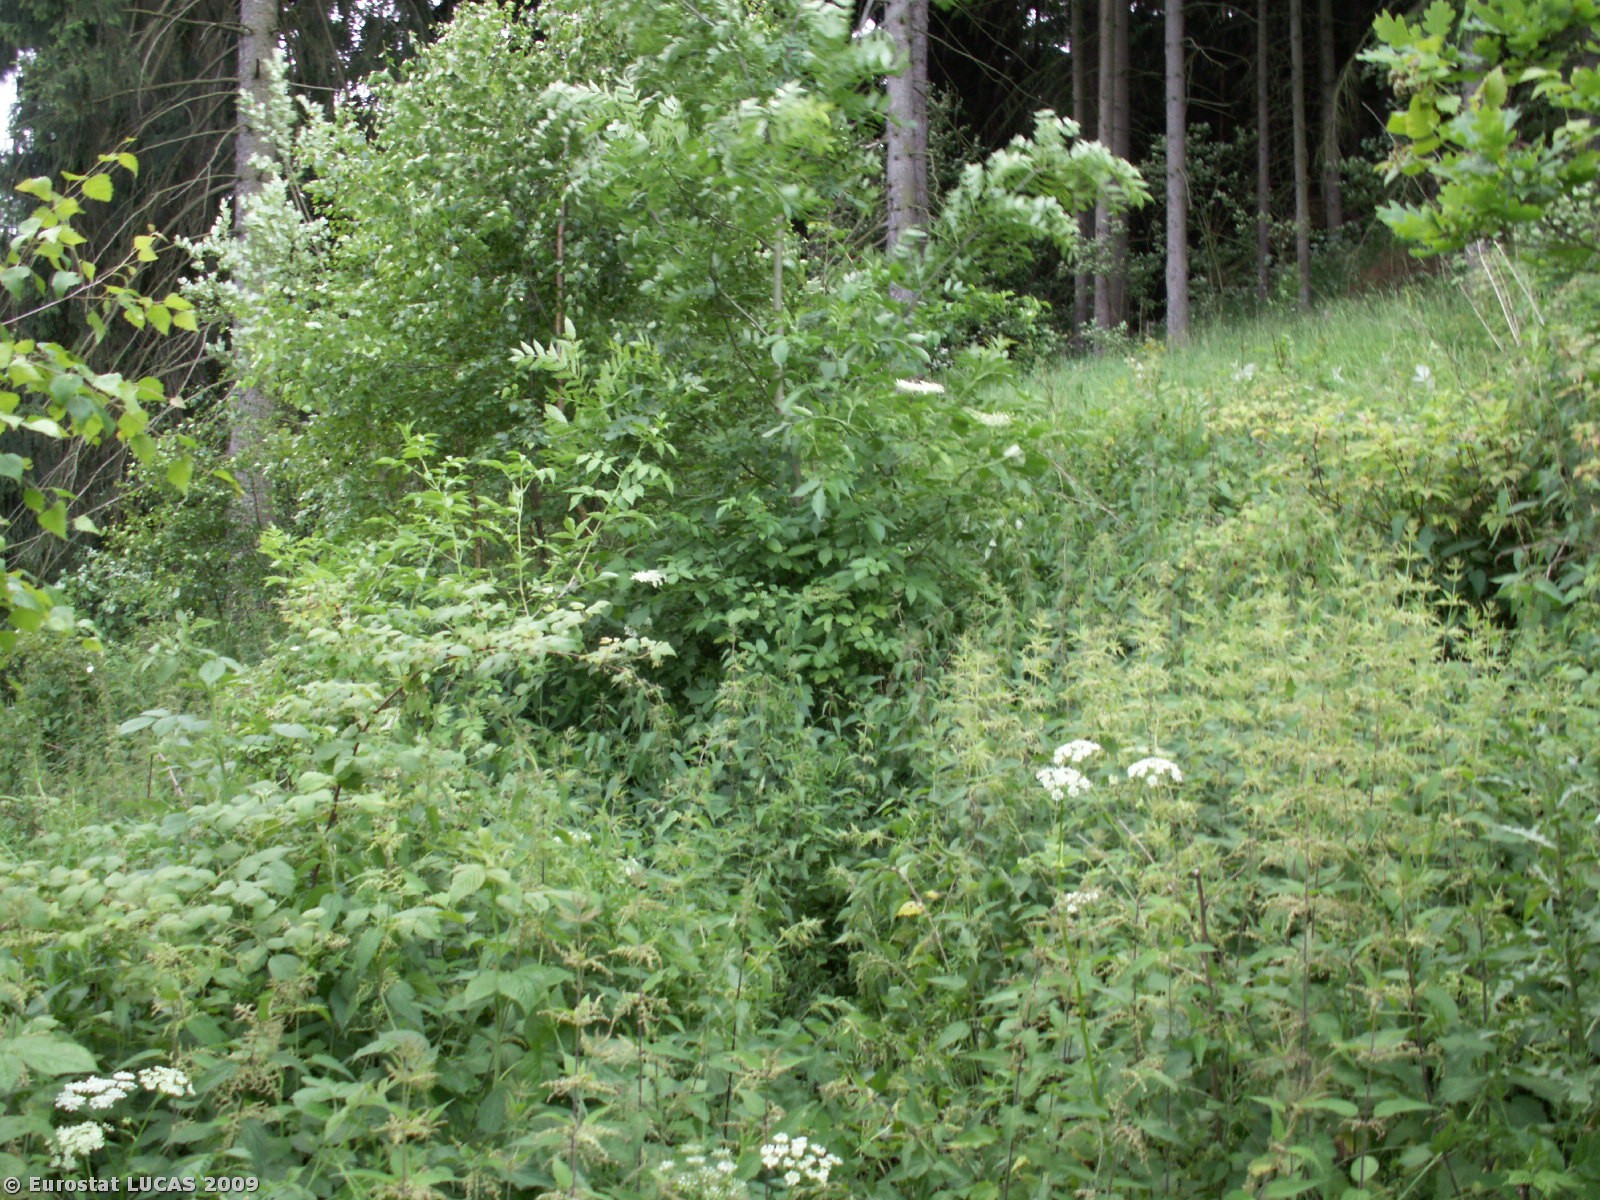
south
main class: Woodland
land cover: Broadleaved woodland
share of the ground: 50 - 75 %
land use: Forestry
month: June
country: CZ
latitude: 50.3242
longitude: 13.0199
